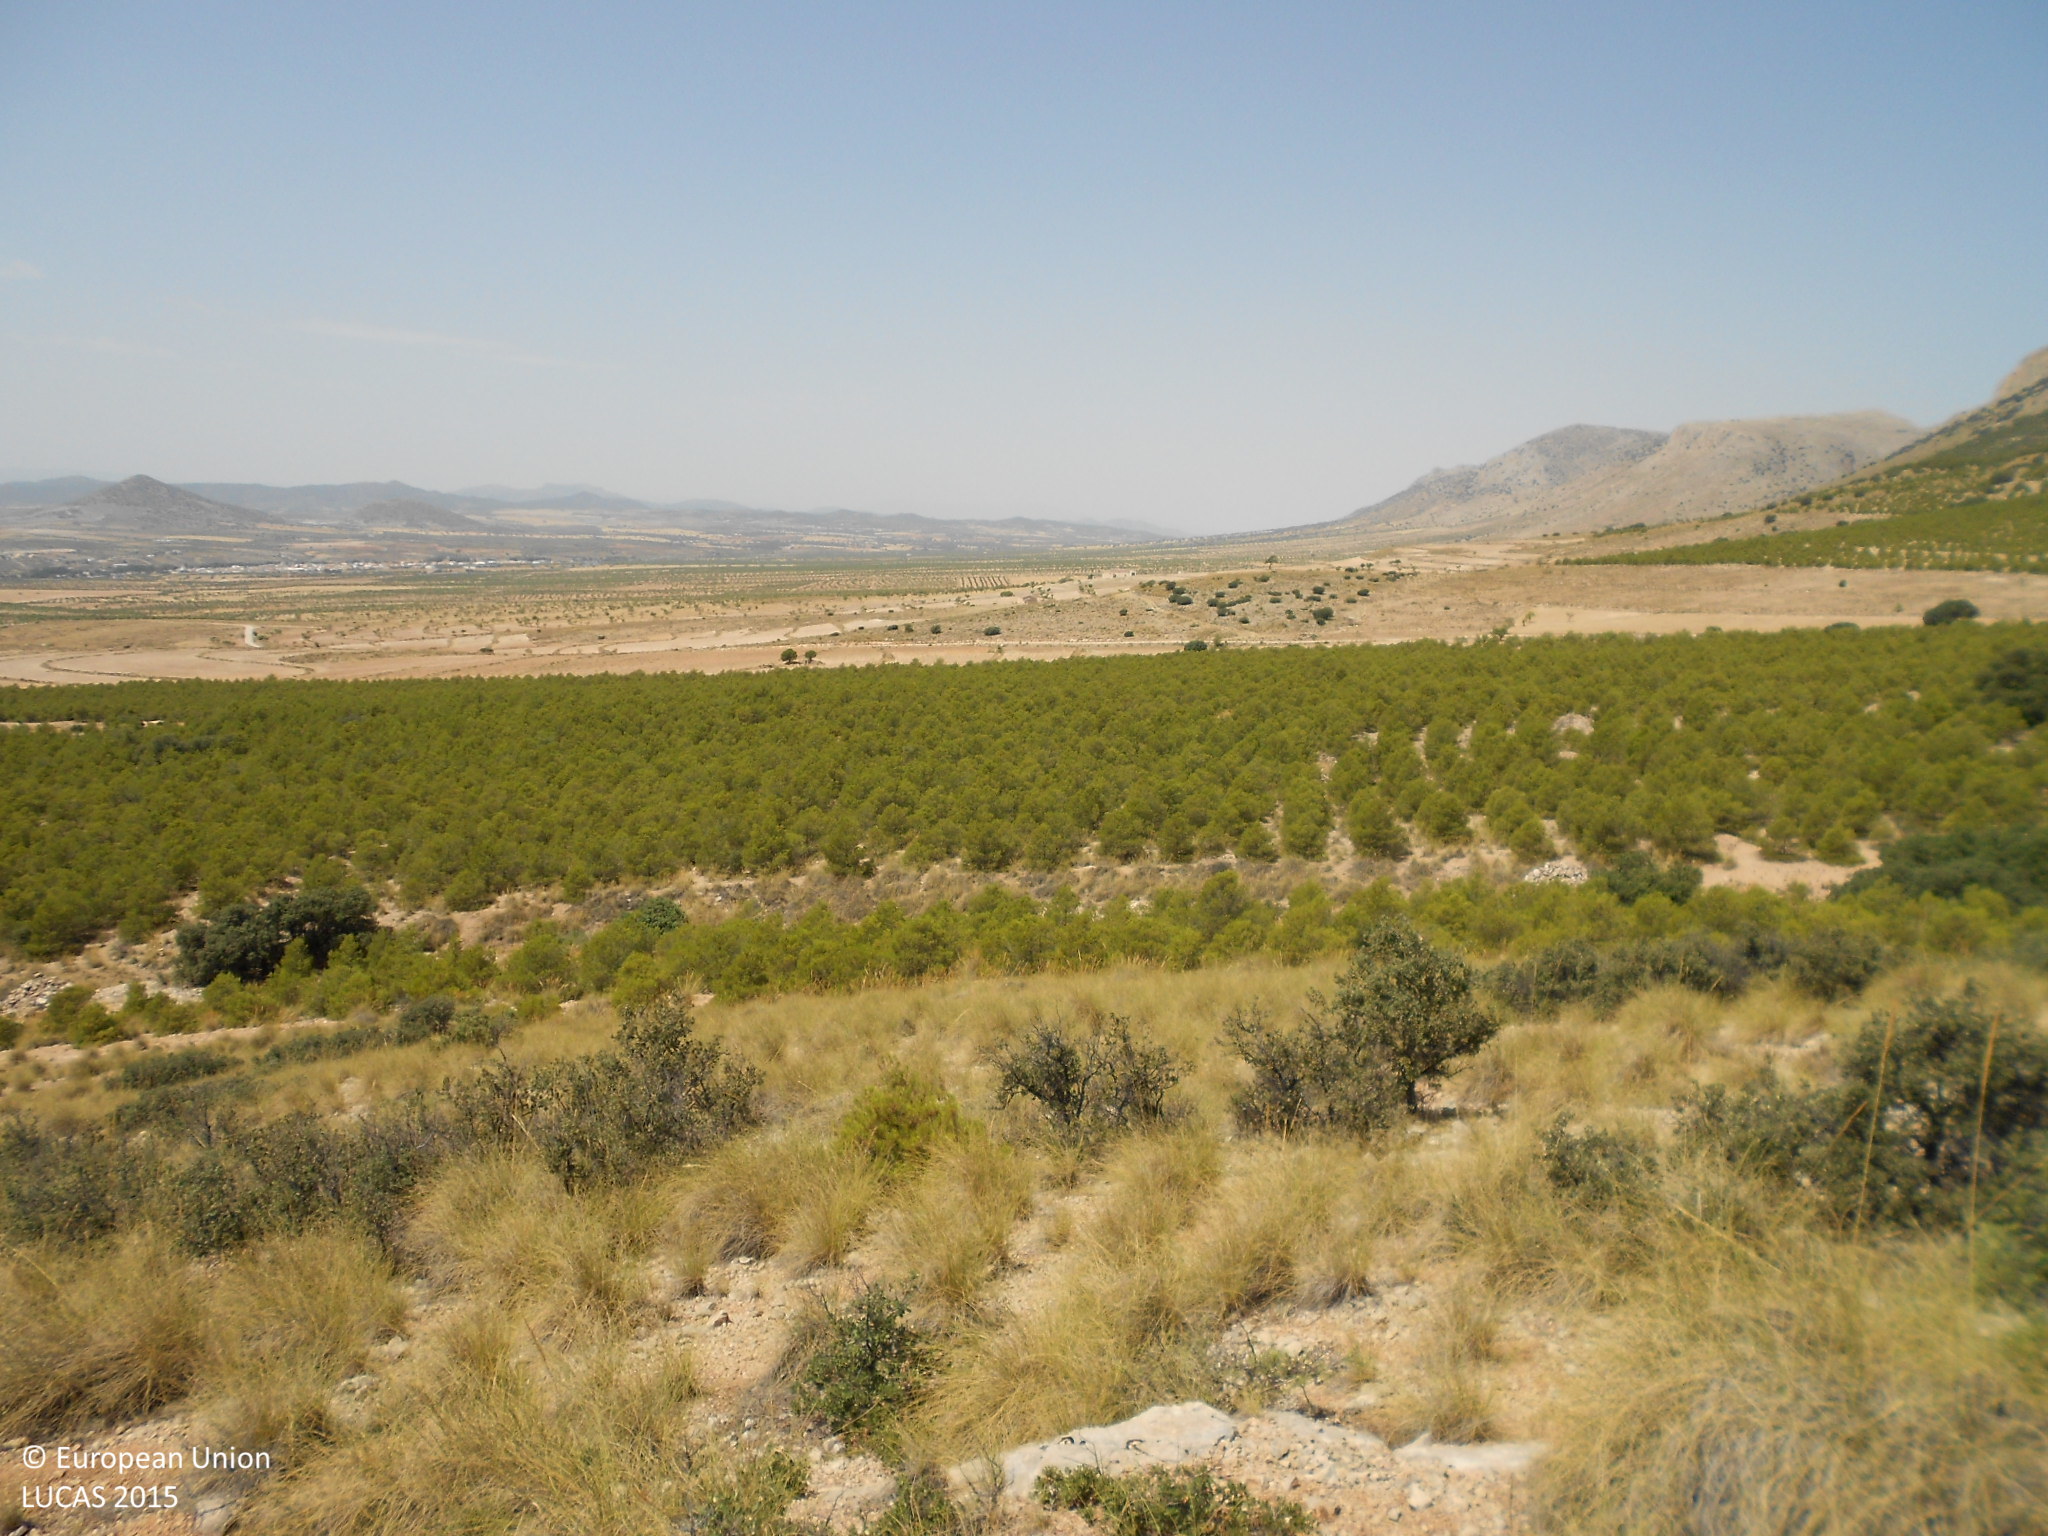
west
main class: Shrubland
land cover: Shrubland without tree cover
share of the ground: 50 - 75 %
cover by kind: shrubs 60 %, herbaceous plants 20 %, consolidated bare surface 20 %
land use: Semi-natural and natural areas not in use
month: July
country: ES
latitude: 37.6322
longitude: -2.2347
